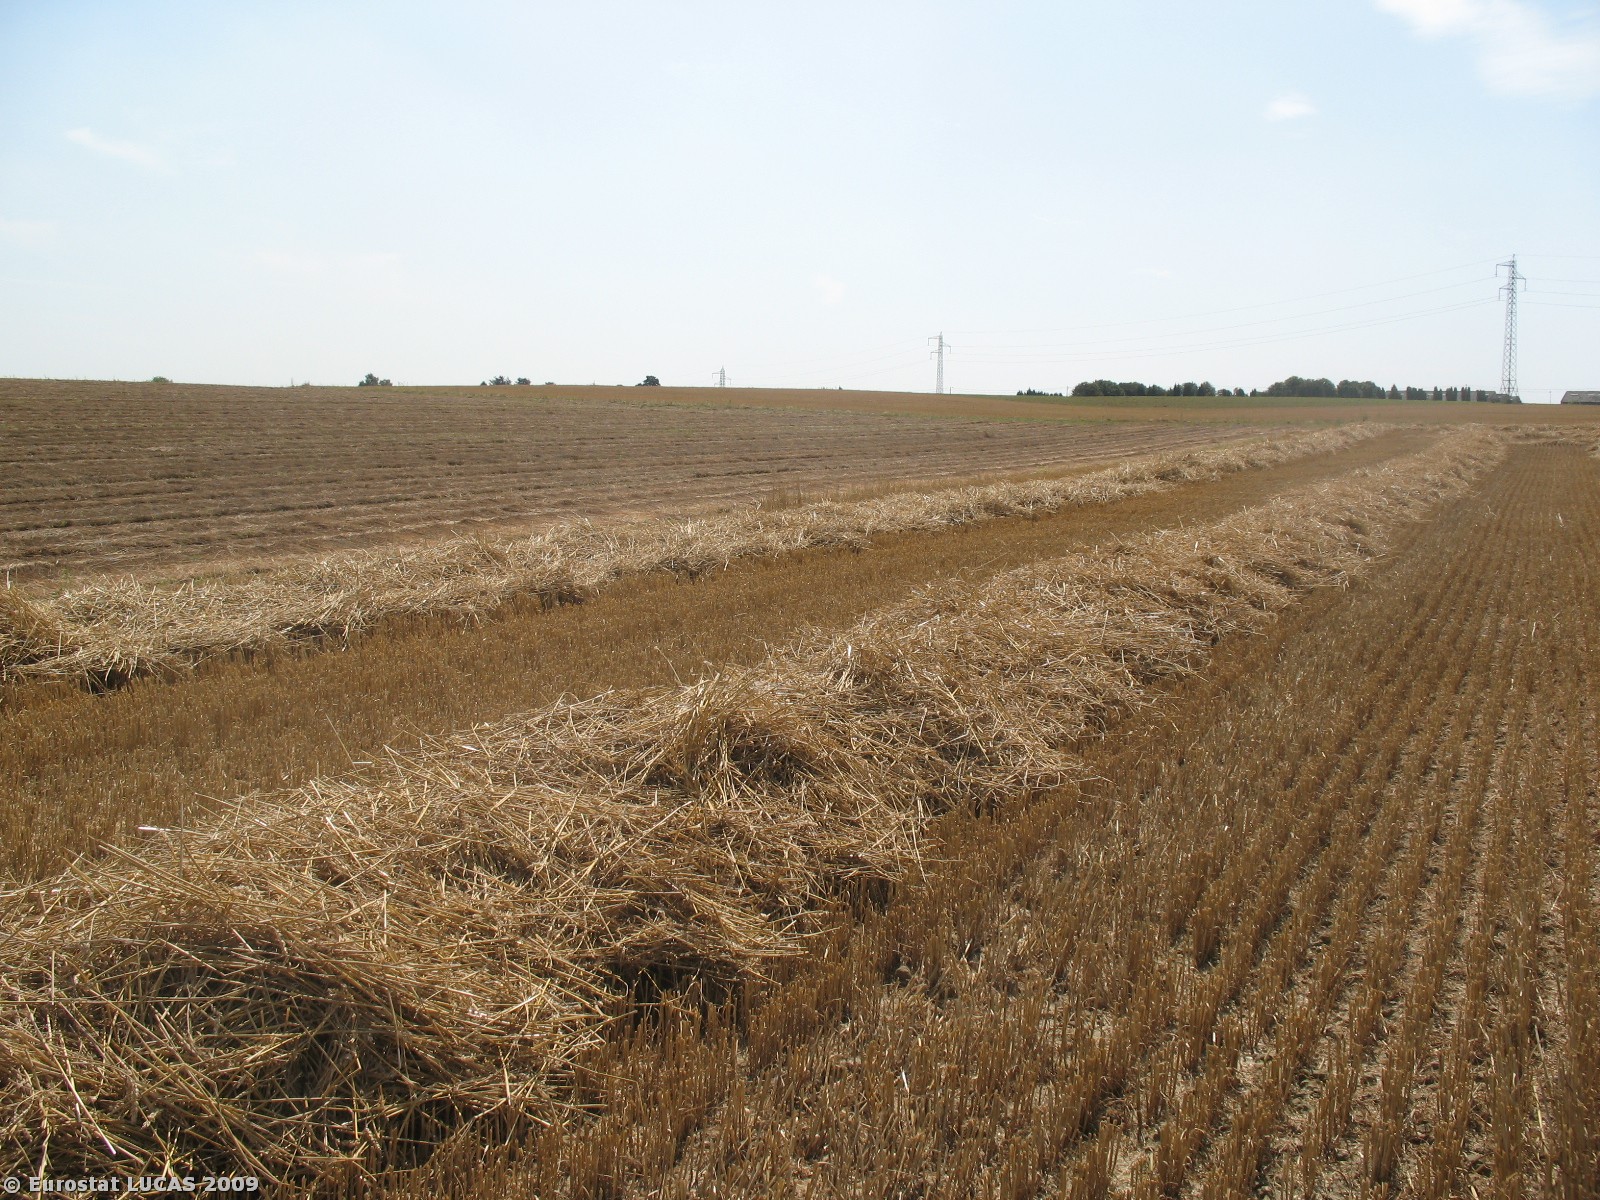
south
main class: Cropland
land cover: Common wheat
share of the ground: > 75 %
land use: Agriculture (excluding fallow land and kitchen gardens)
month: August
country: BE
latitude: 50.6406
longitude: 4.3817
